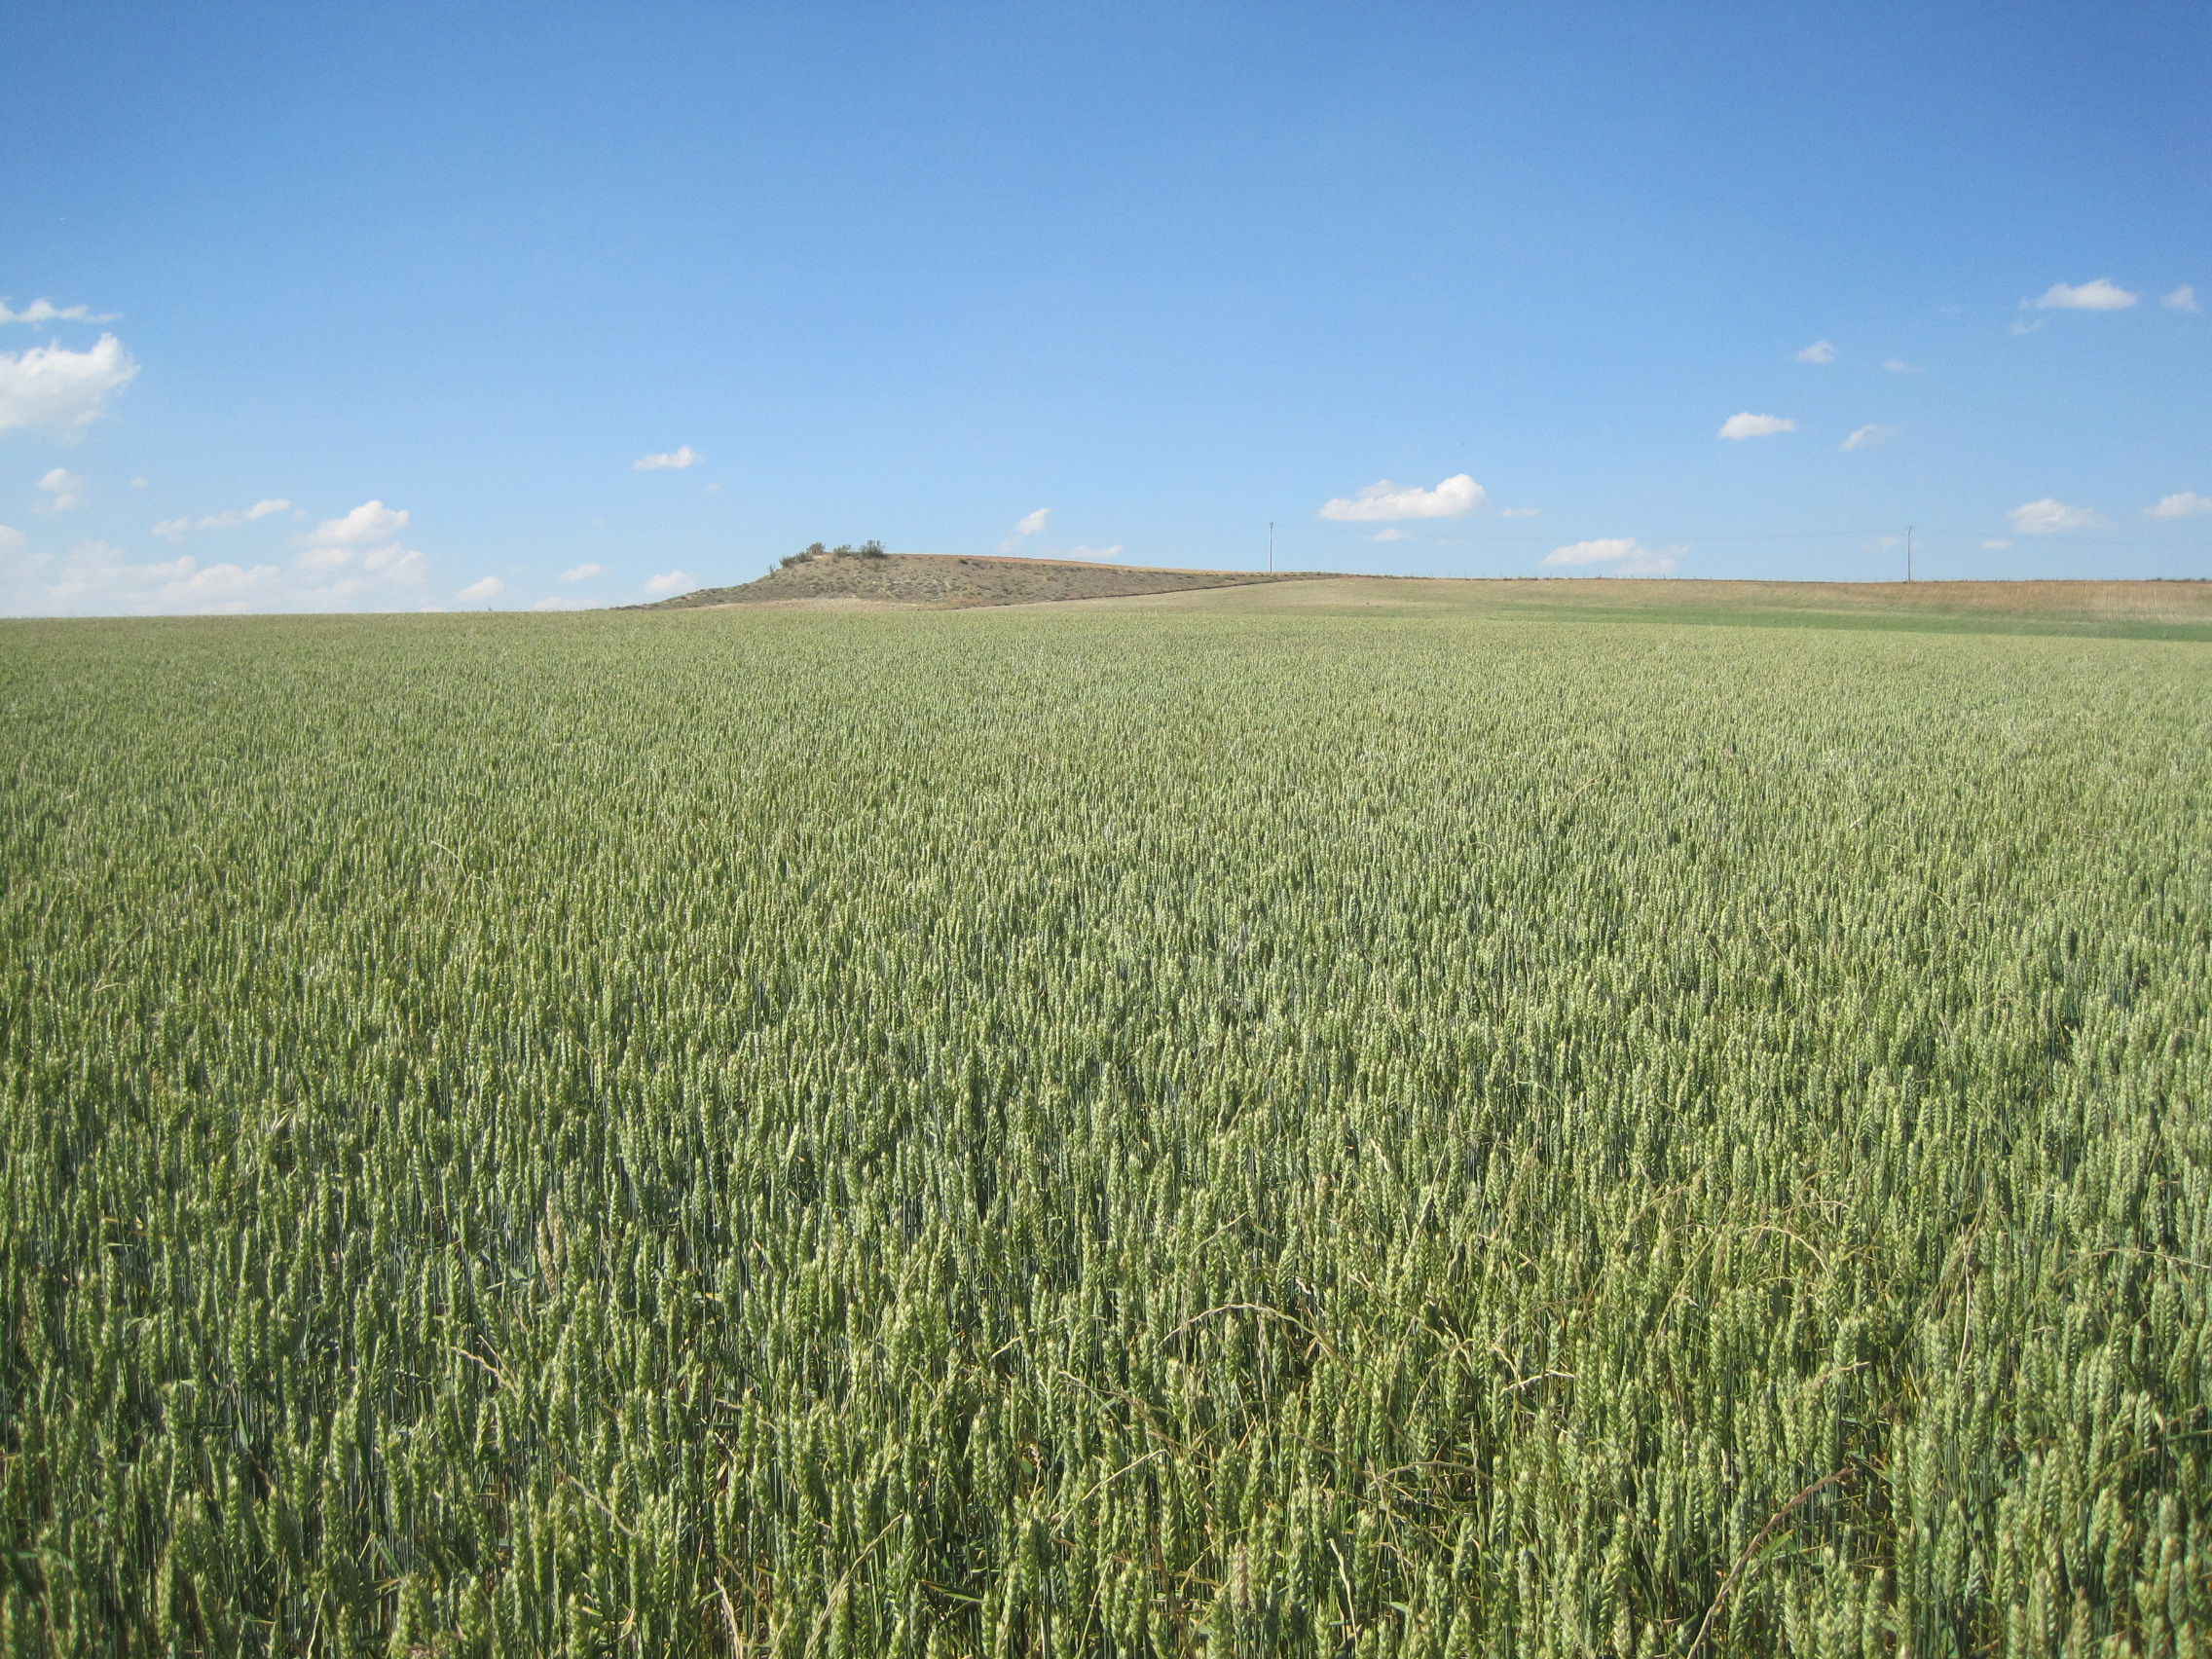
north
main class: Cropland
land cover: Common wheat
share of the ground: > 75 %
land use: Agriculture (excluding fallow land and kitchen gardens)
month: May
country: ES
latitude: 41.3219
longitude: -5.0397
